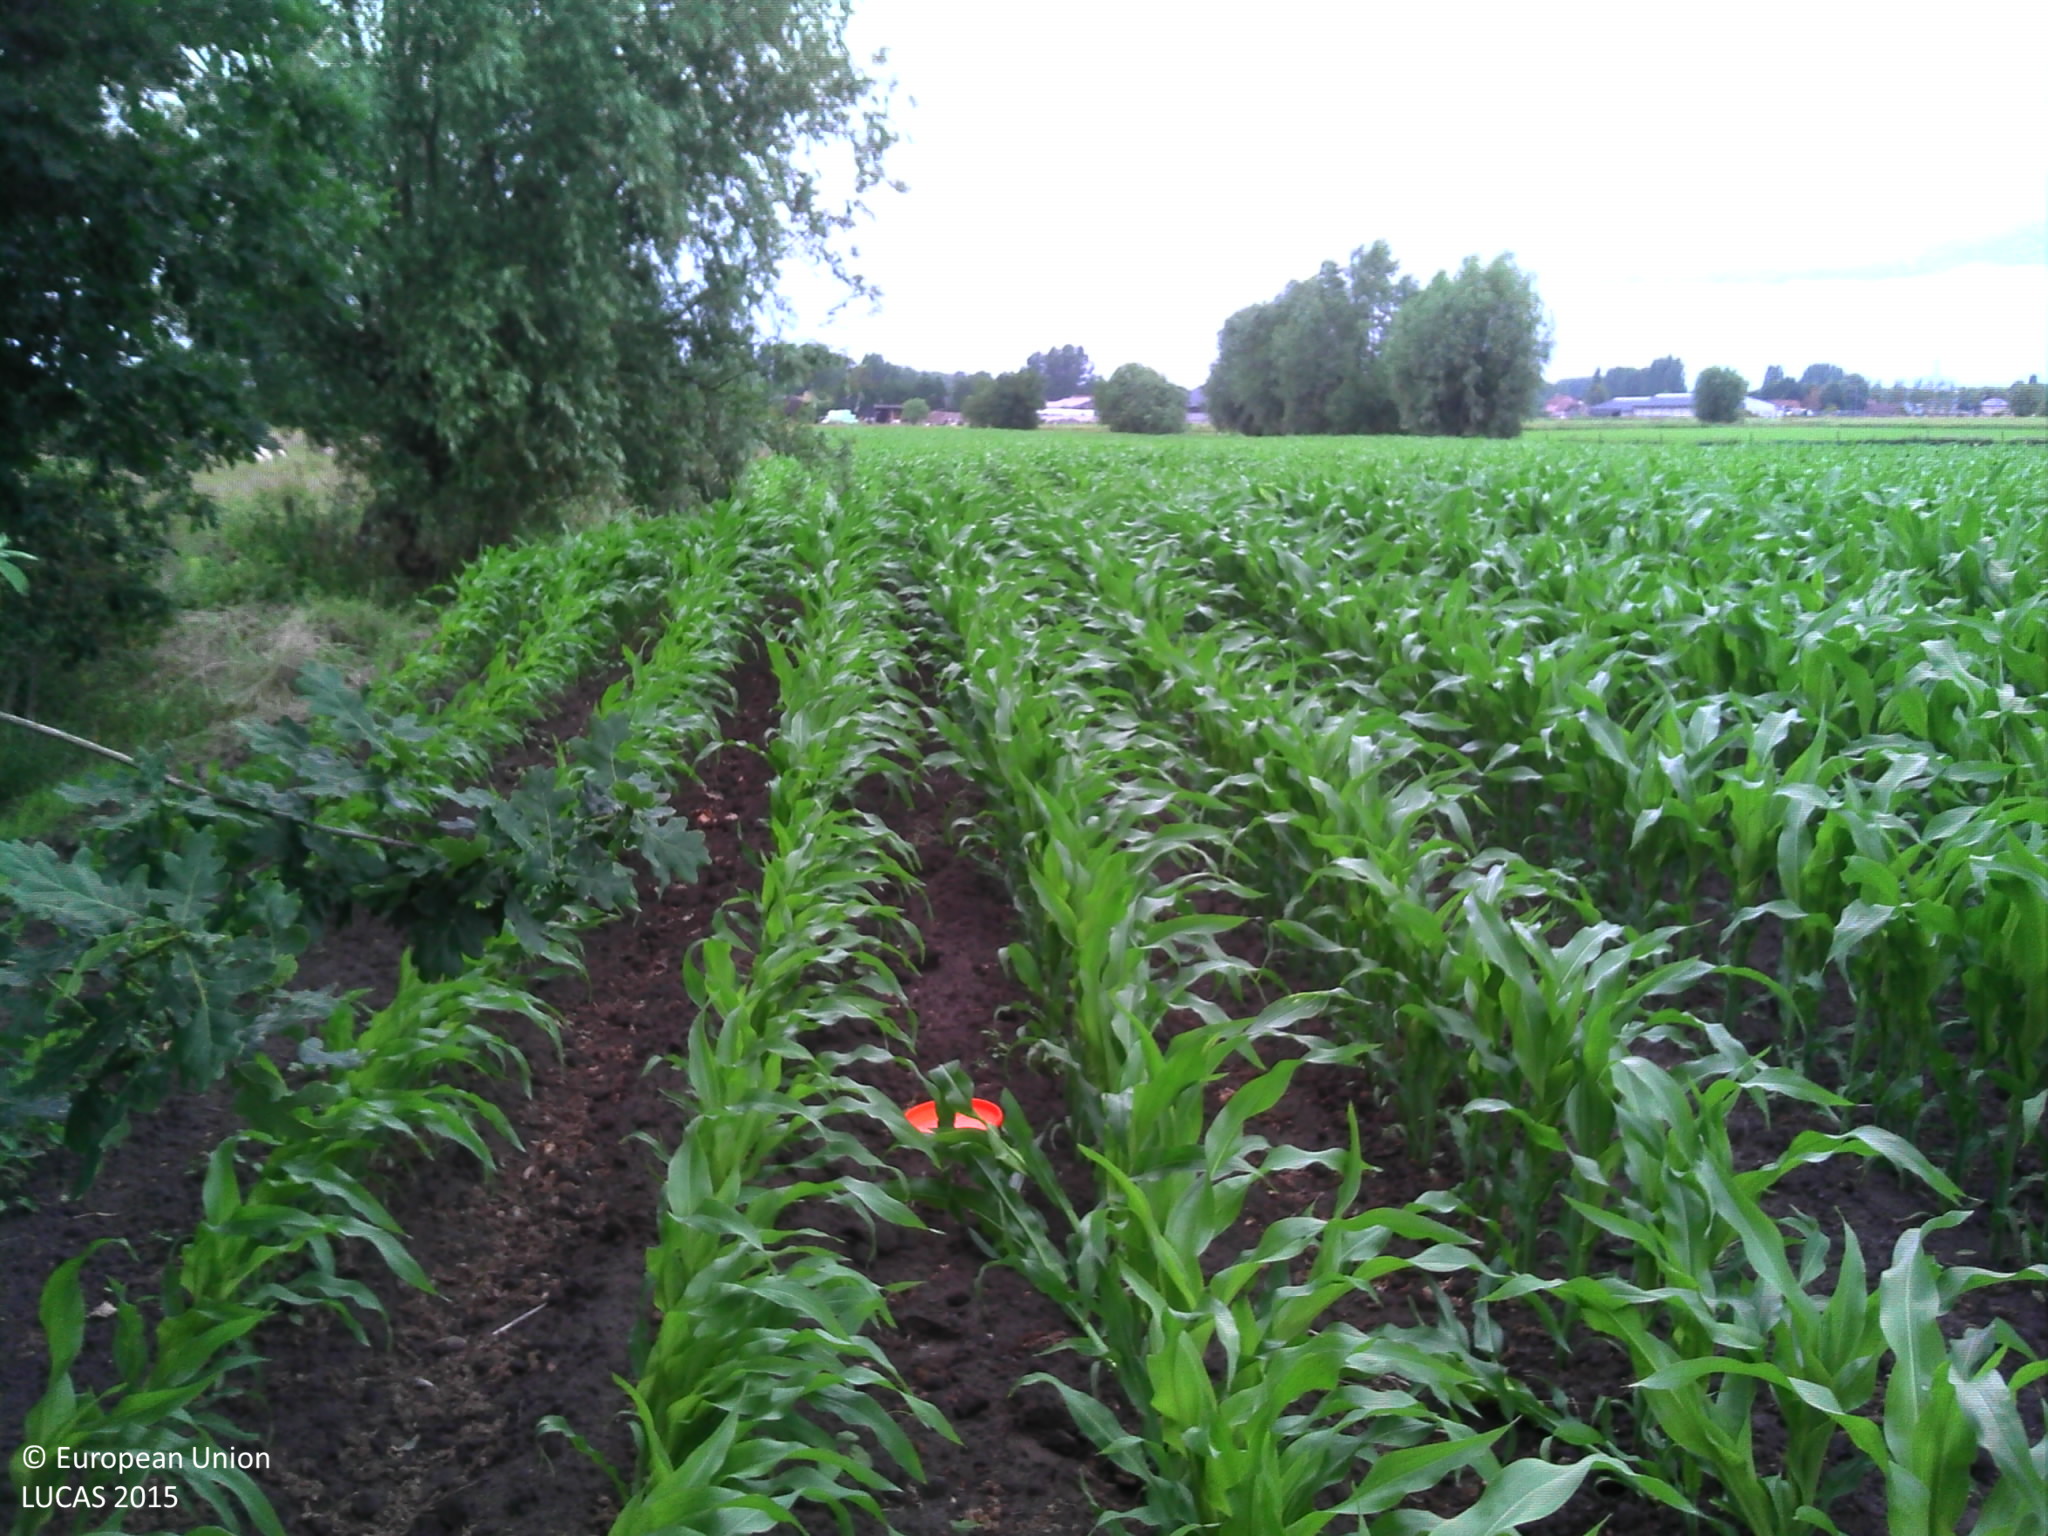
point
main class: Cropland
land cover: Maize
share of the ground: > 75 %
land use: Agriculture (excluding fallow land and kitchen gardens)
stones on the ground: < 10 %
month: June
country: BE
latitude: 51.1205
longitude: 3.8932
